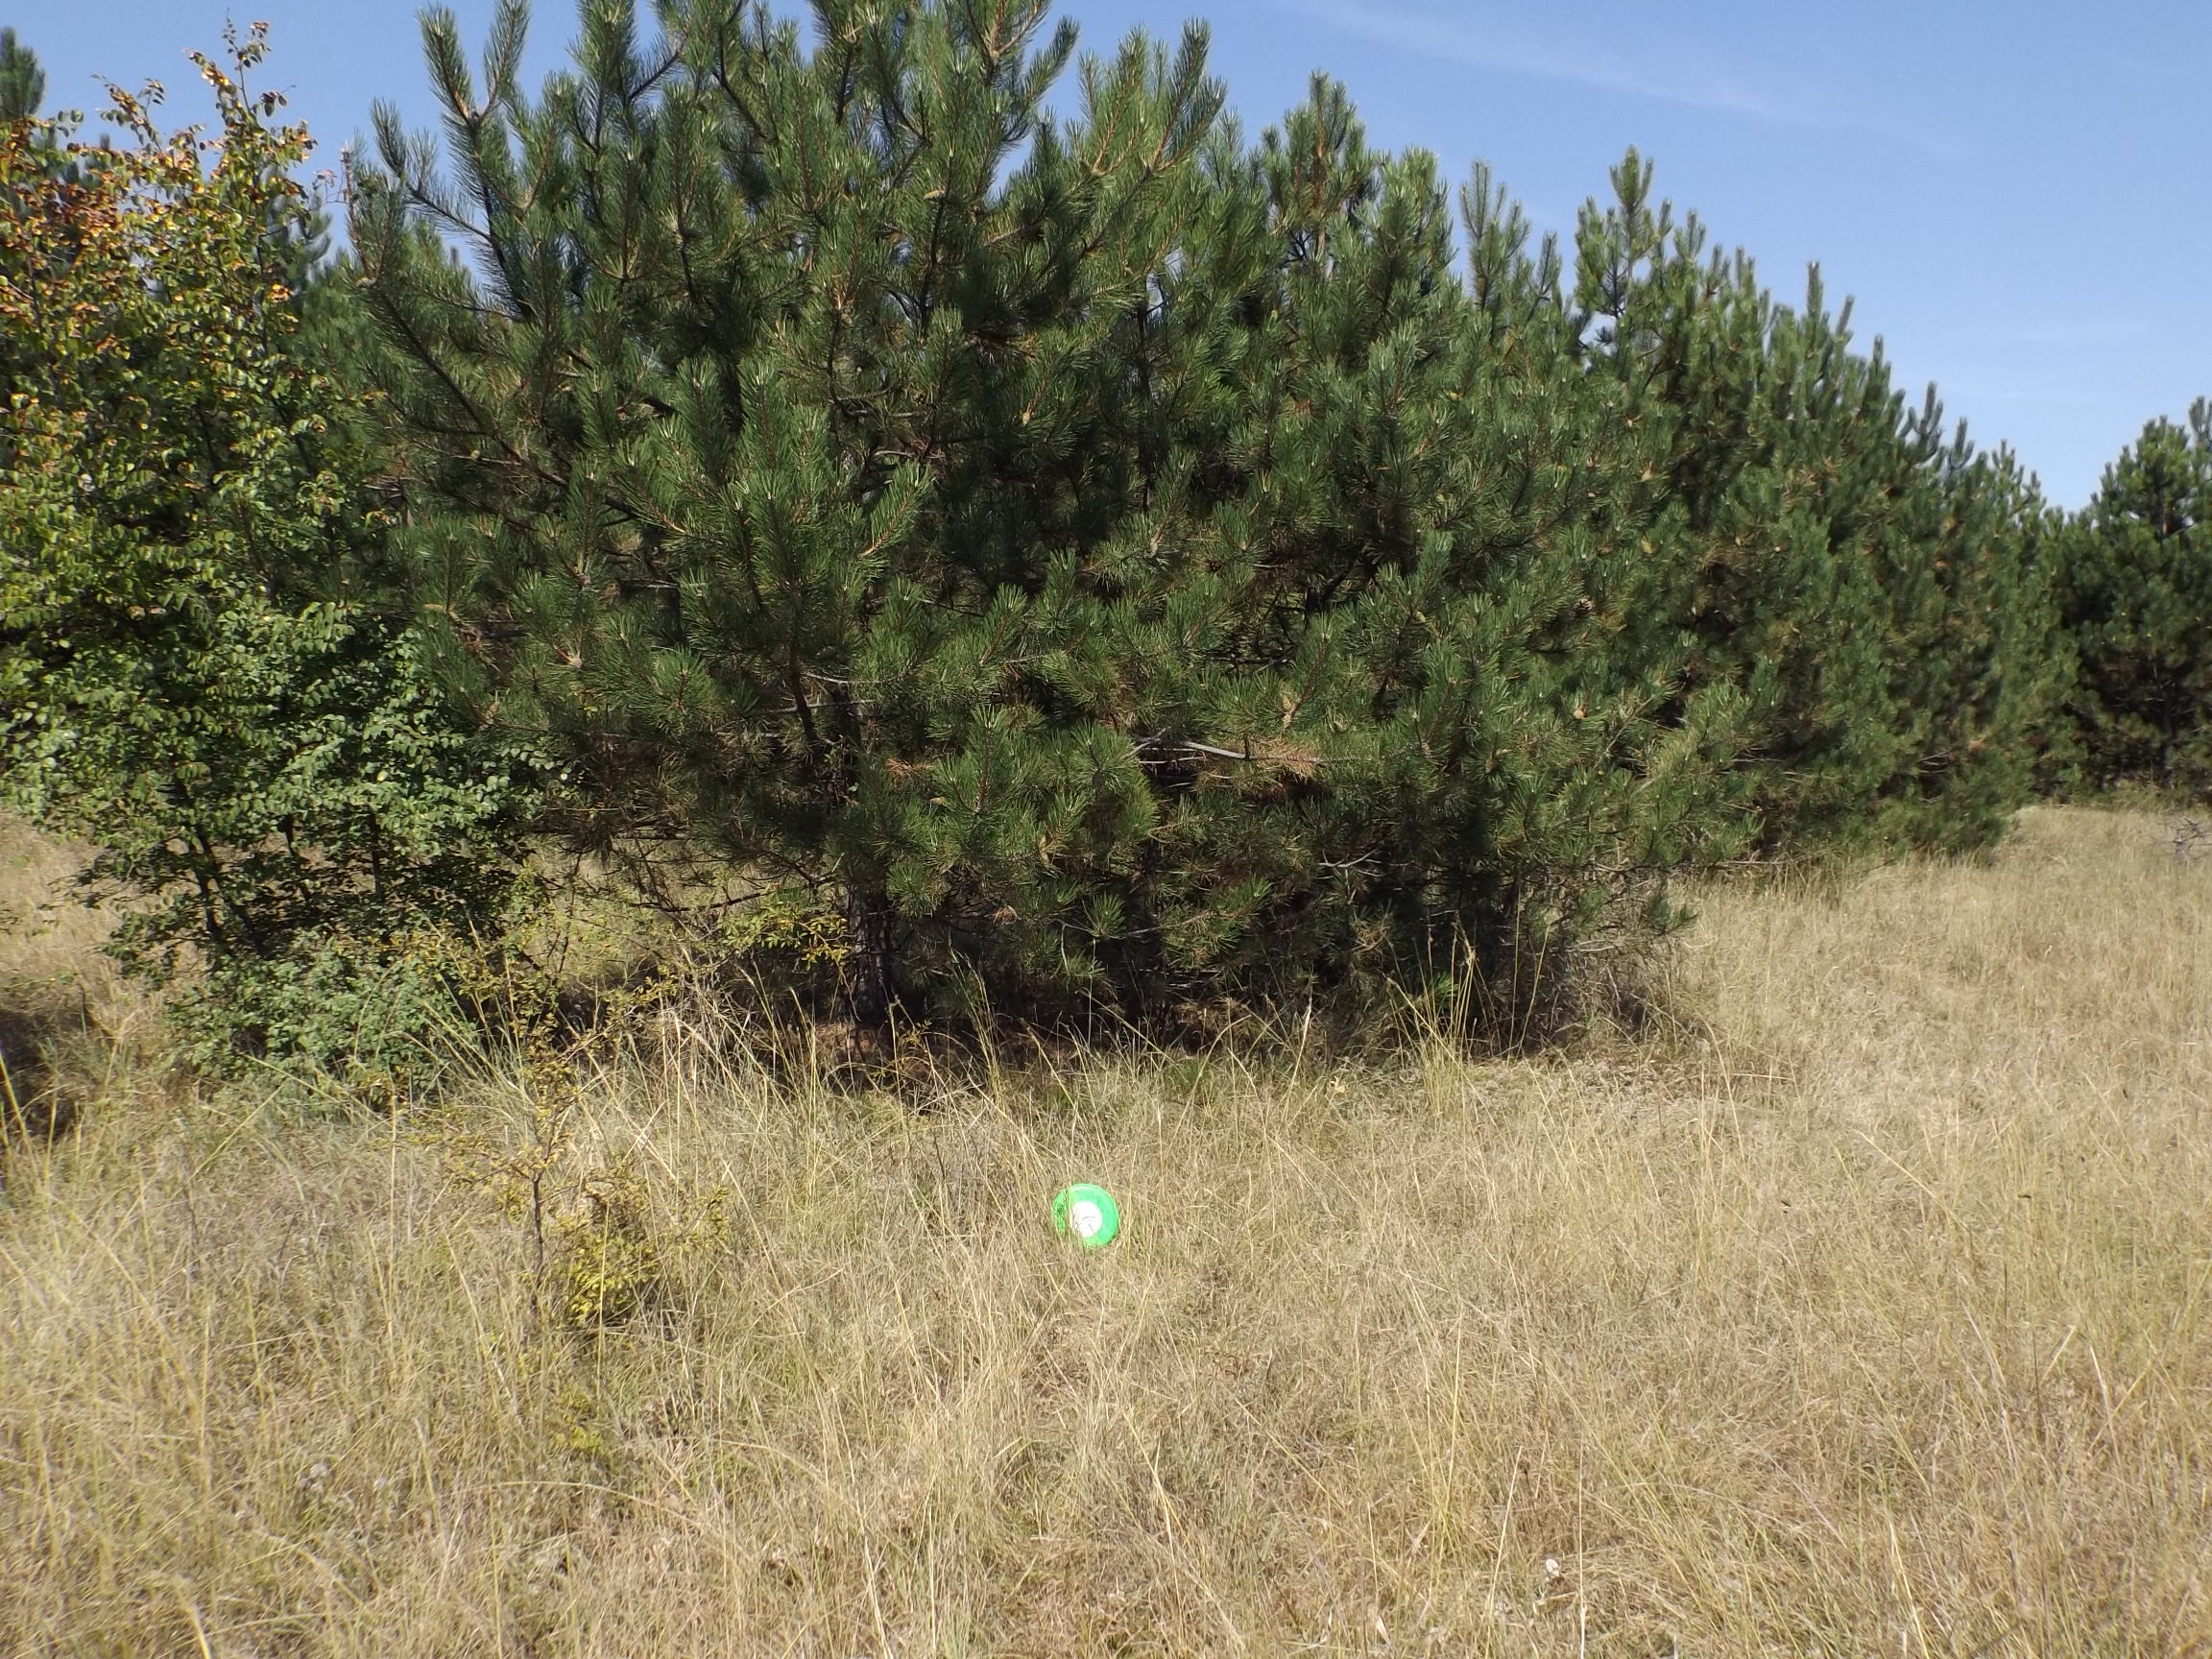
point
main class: Woodland
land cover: Pine dominated coniferous woodland
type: alpine coniferous forest
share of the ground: 50 - 75 %
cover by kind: coniferous forest trees 55 %, herbaceous plants 40 %, shrubs 5 %
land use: Forestry
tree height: < 5 m
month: August
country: BG
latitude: 43.0906
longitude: 27.3827
